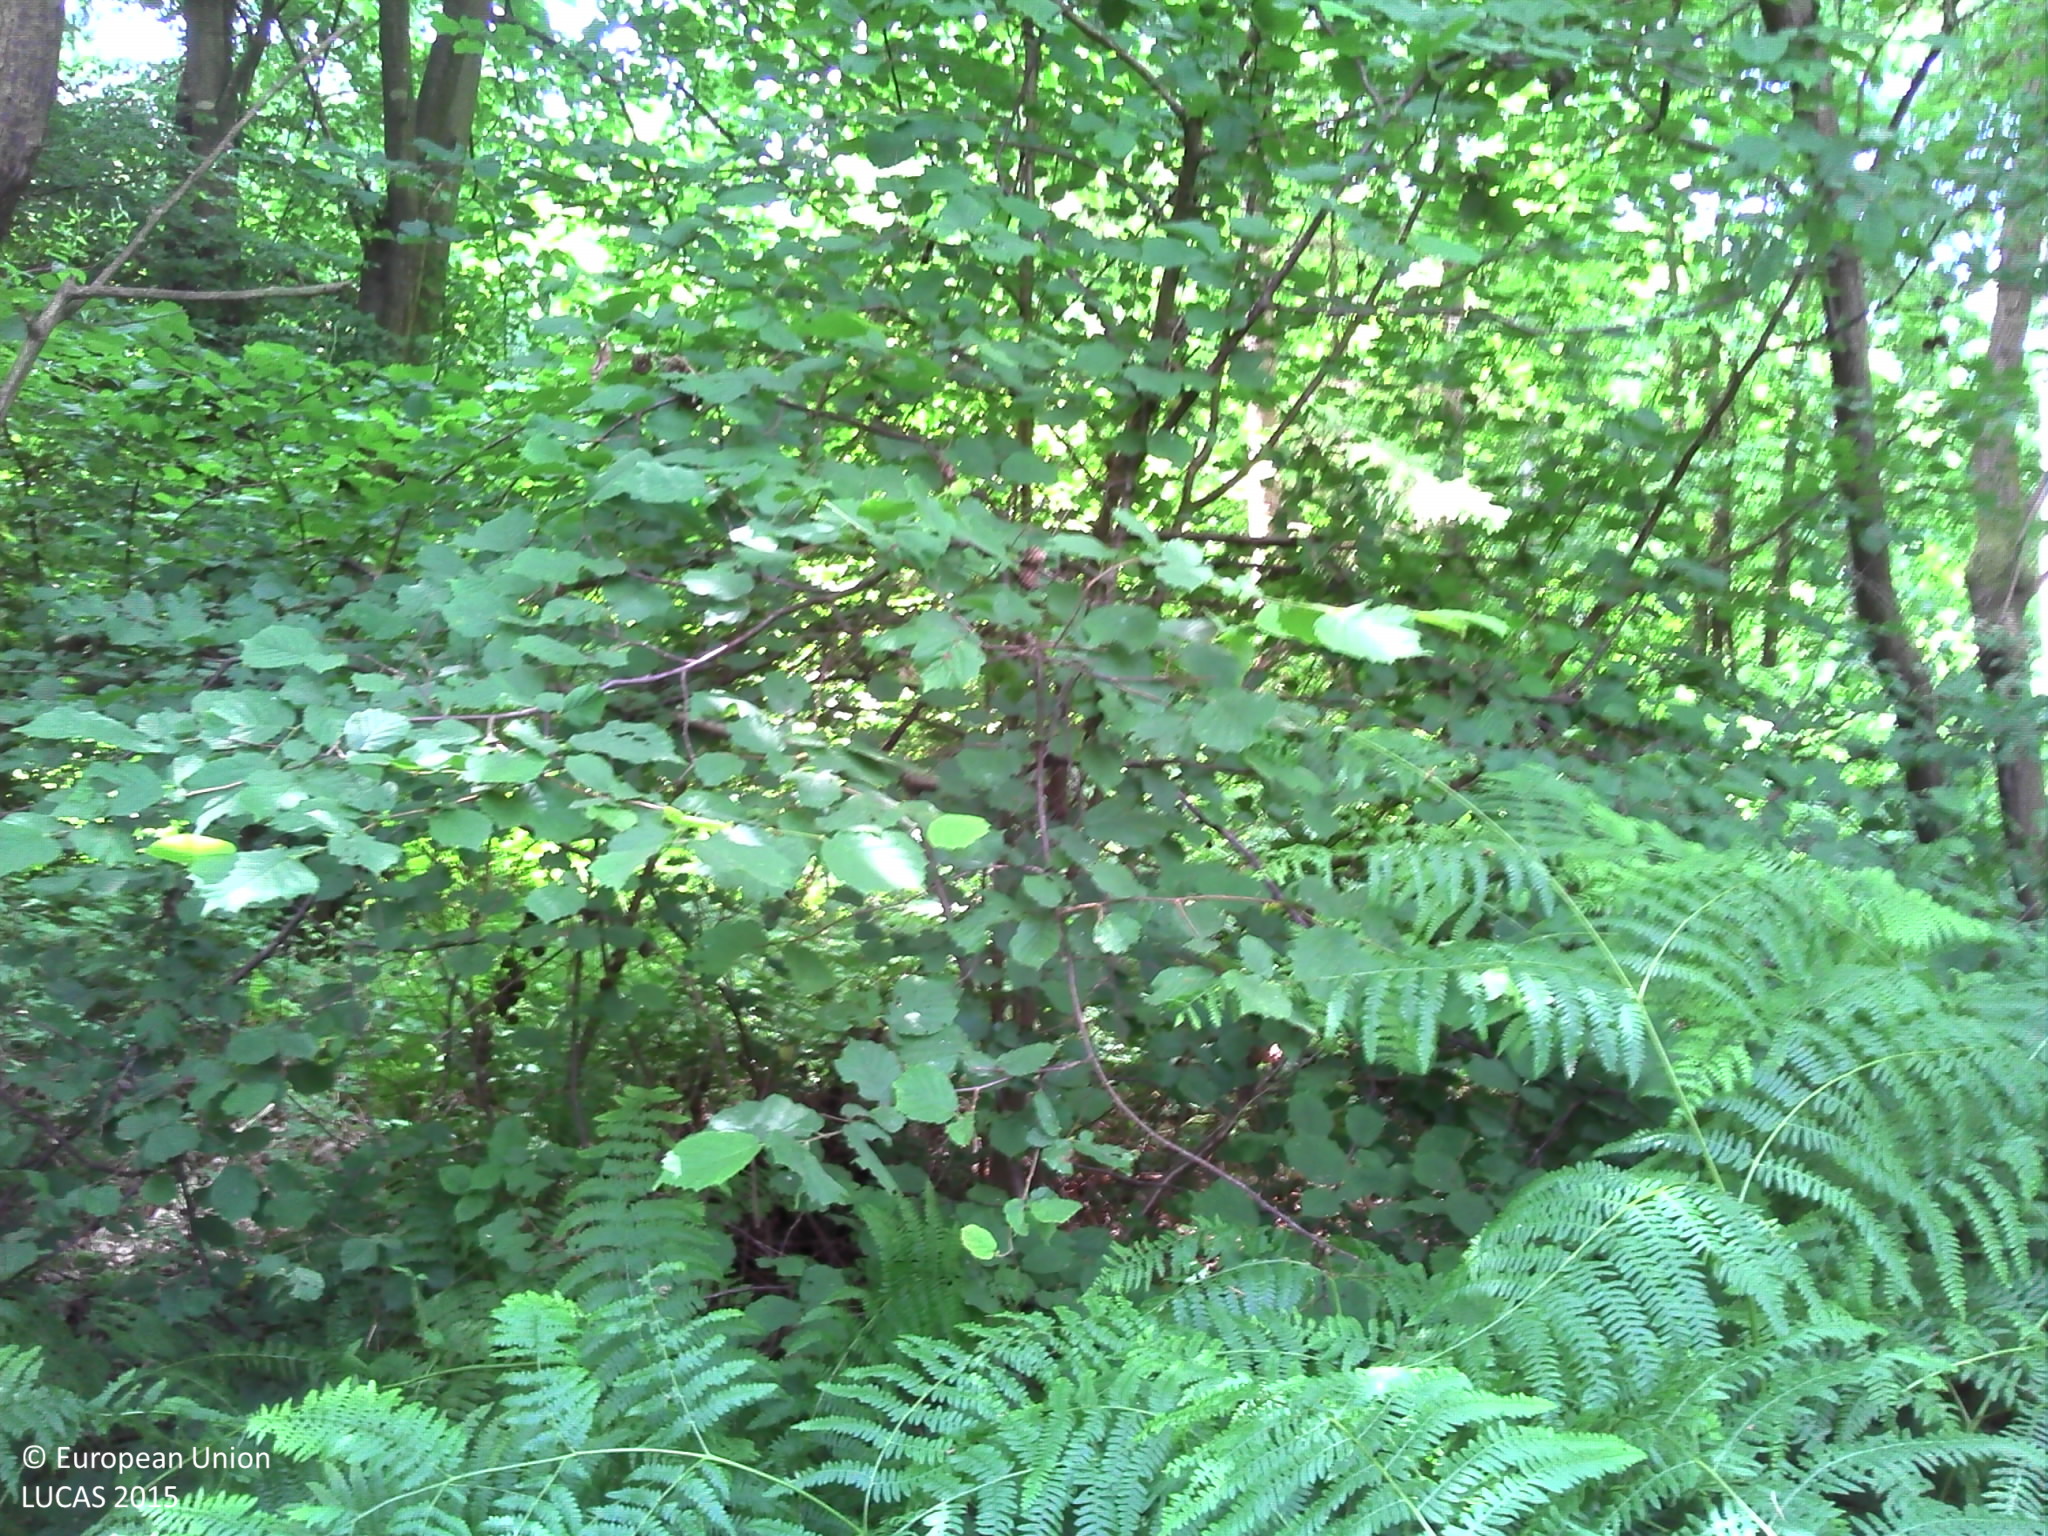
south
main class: Woodland
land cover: Spruce dominated mixed woodland
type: mesophytic deciduous forest
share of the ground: > 75 %
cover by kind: broadleaved forest trees 50 %, coniferous forest trees 40 %, herbaceous plants 10 %
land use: Forestry
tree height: > 5 m
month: June
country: FR
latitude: 49.2422
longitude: 1.1471
